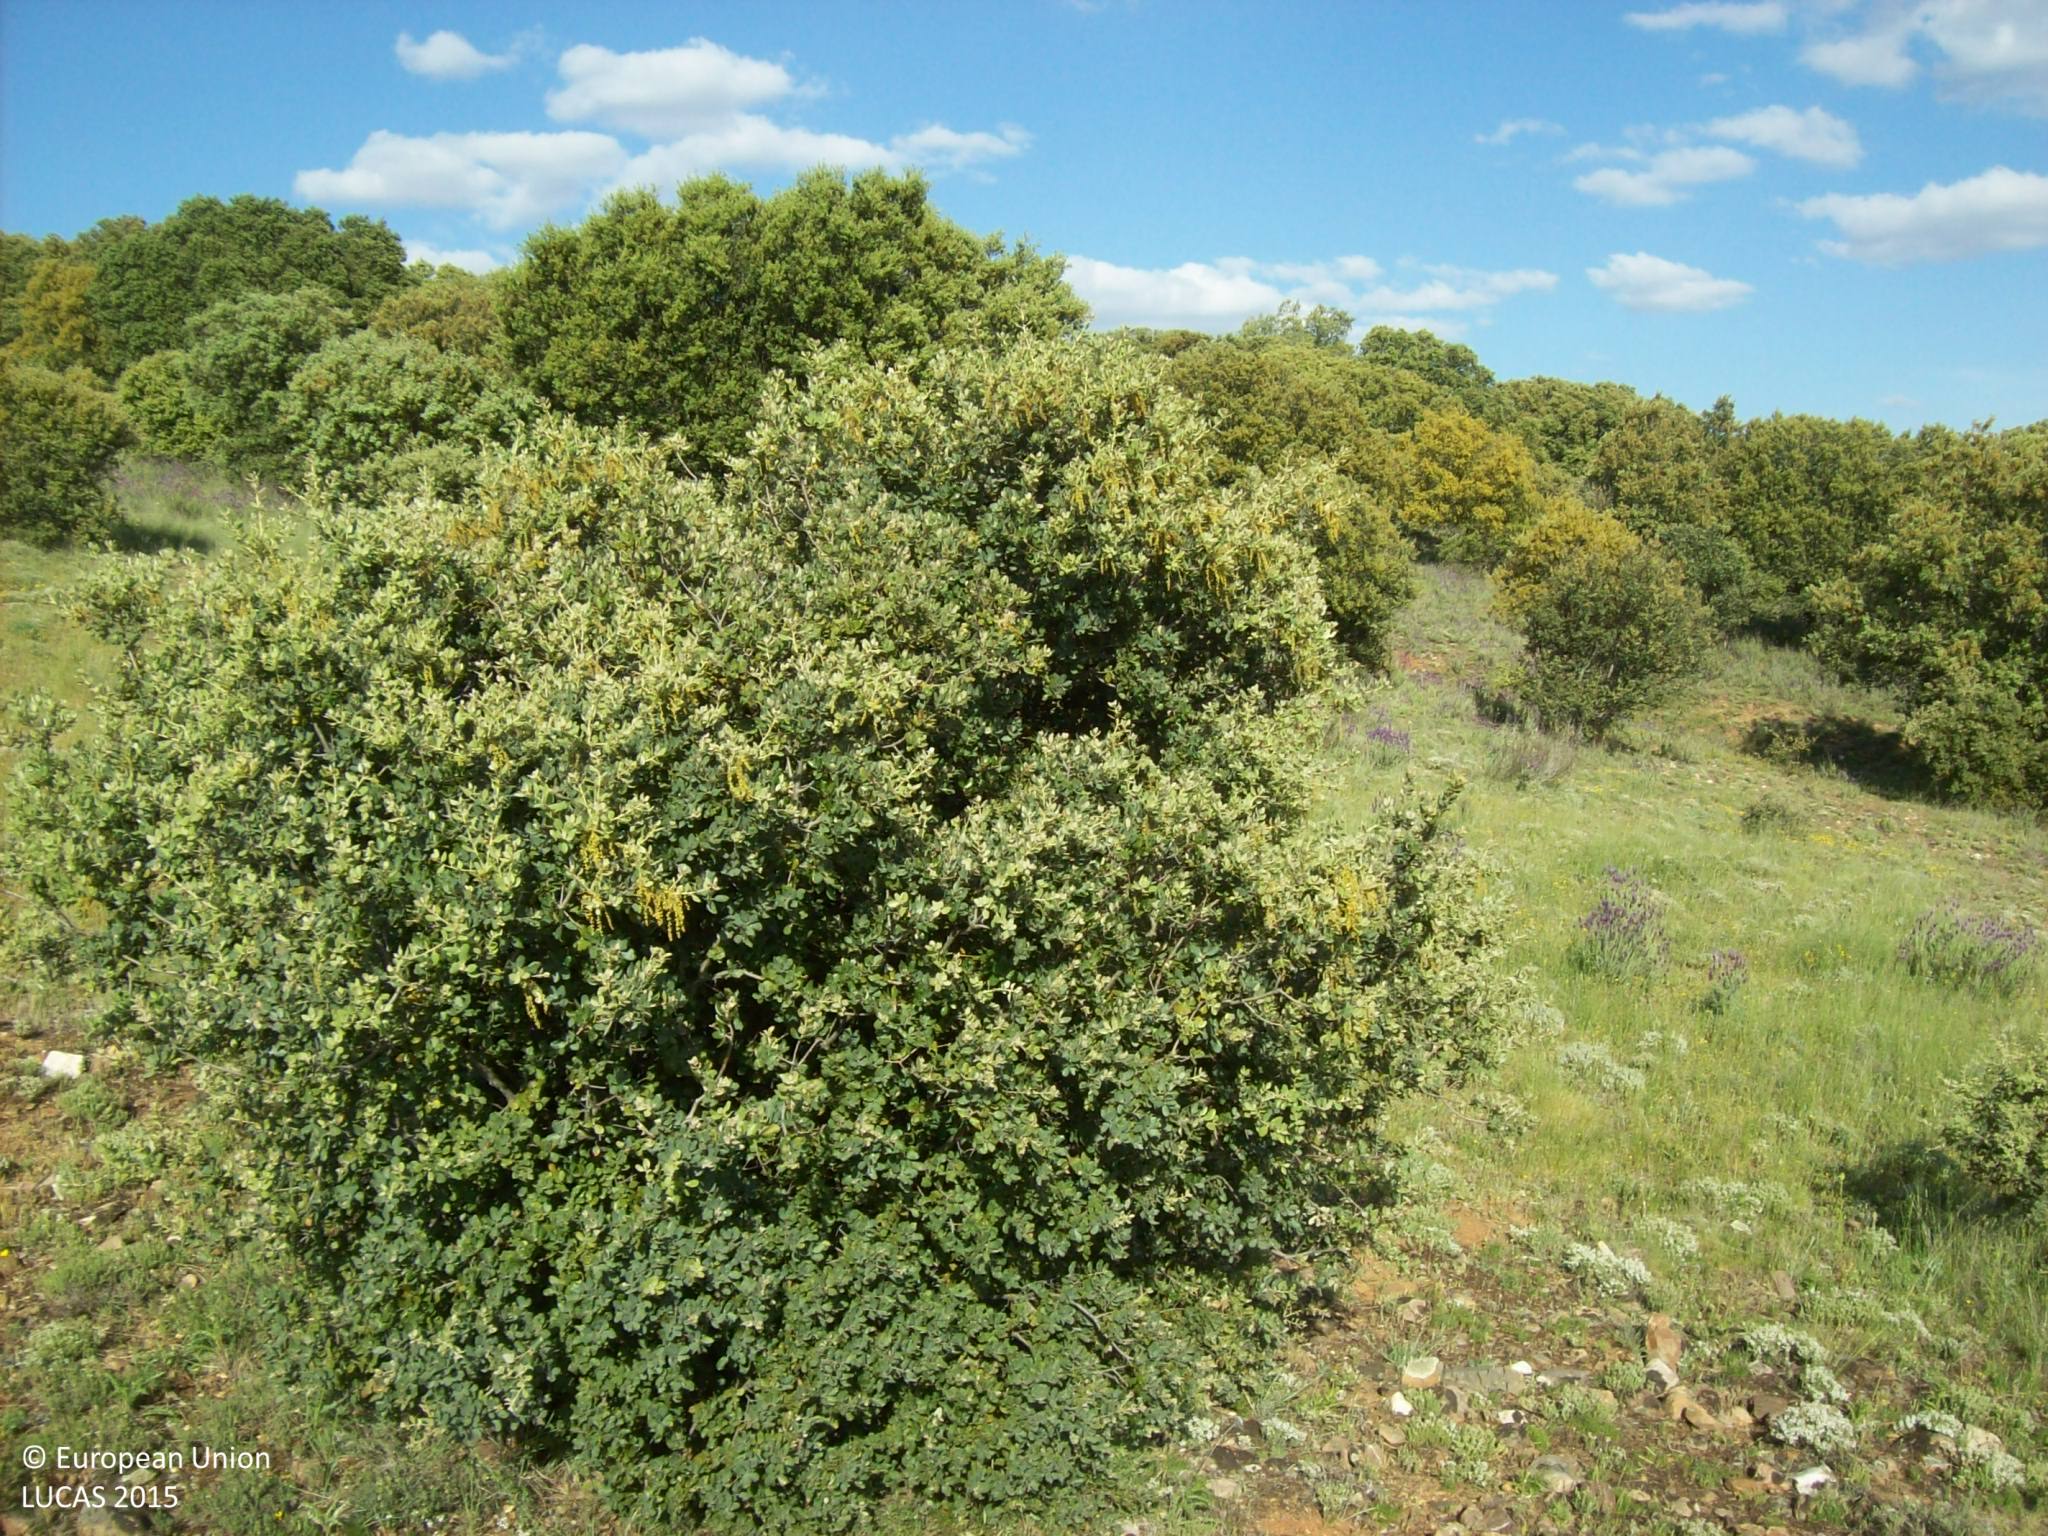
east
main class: Shrubland
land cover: Shrubland with sparse tree cover
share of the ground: 50 - 75 %
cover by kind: shrubs 60 %, lichens and mosses 20 %, herbaceous plants 15 %, broadleaved forest trees 5 %
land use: Semi-natural and natural areas not in use
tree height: < 5 m
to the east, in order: Shrubland with sparse tree cover; Broadleaved woodland; Tracks; Fences; Broadleaved woodland; Tracks; Broadleaved woodland
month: May
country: ES
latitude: 40.7833
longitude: -4.4748
